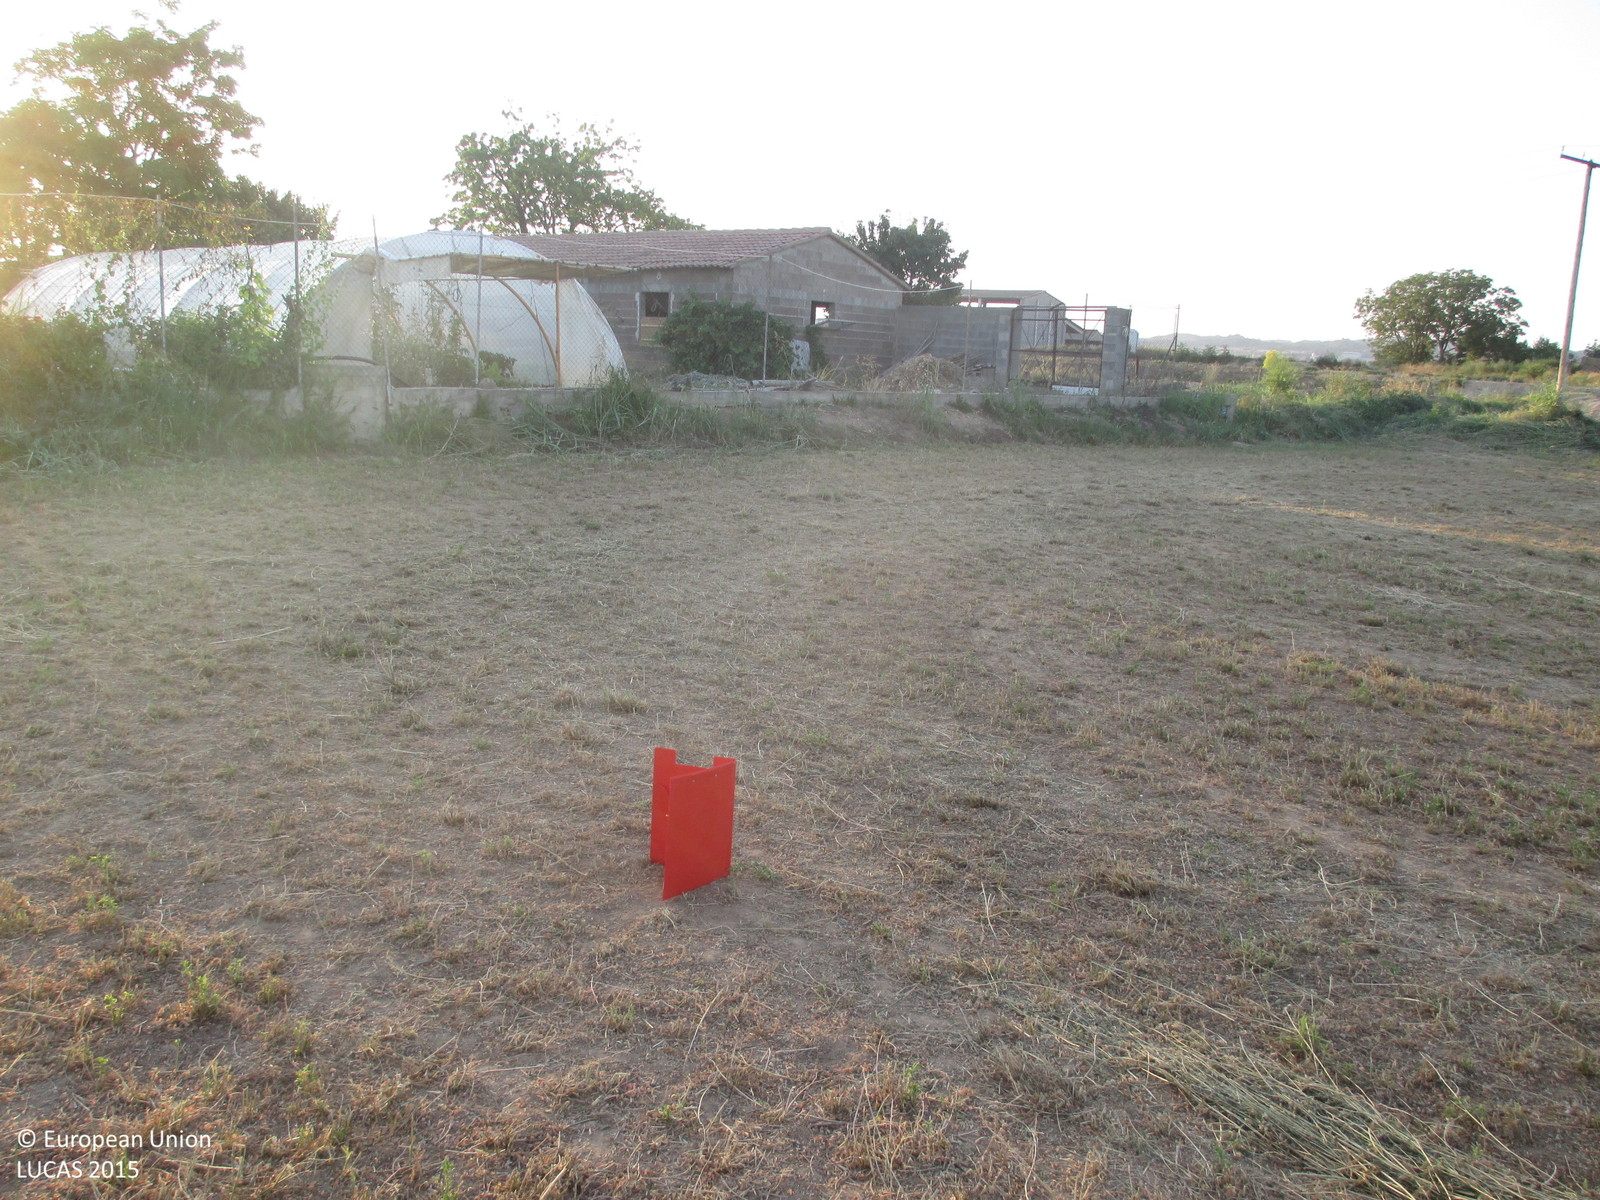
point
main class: Cropland
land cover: Lucerne
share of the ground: > 75 %
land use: Agriculture (excluding fallow land and kitchen gardens)
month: July
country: ES
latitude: 41.8502
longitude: 0.3851
